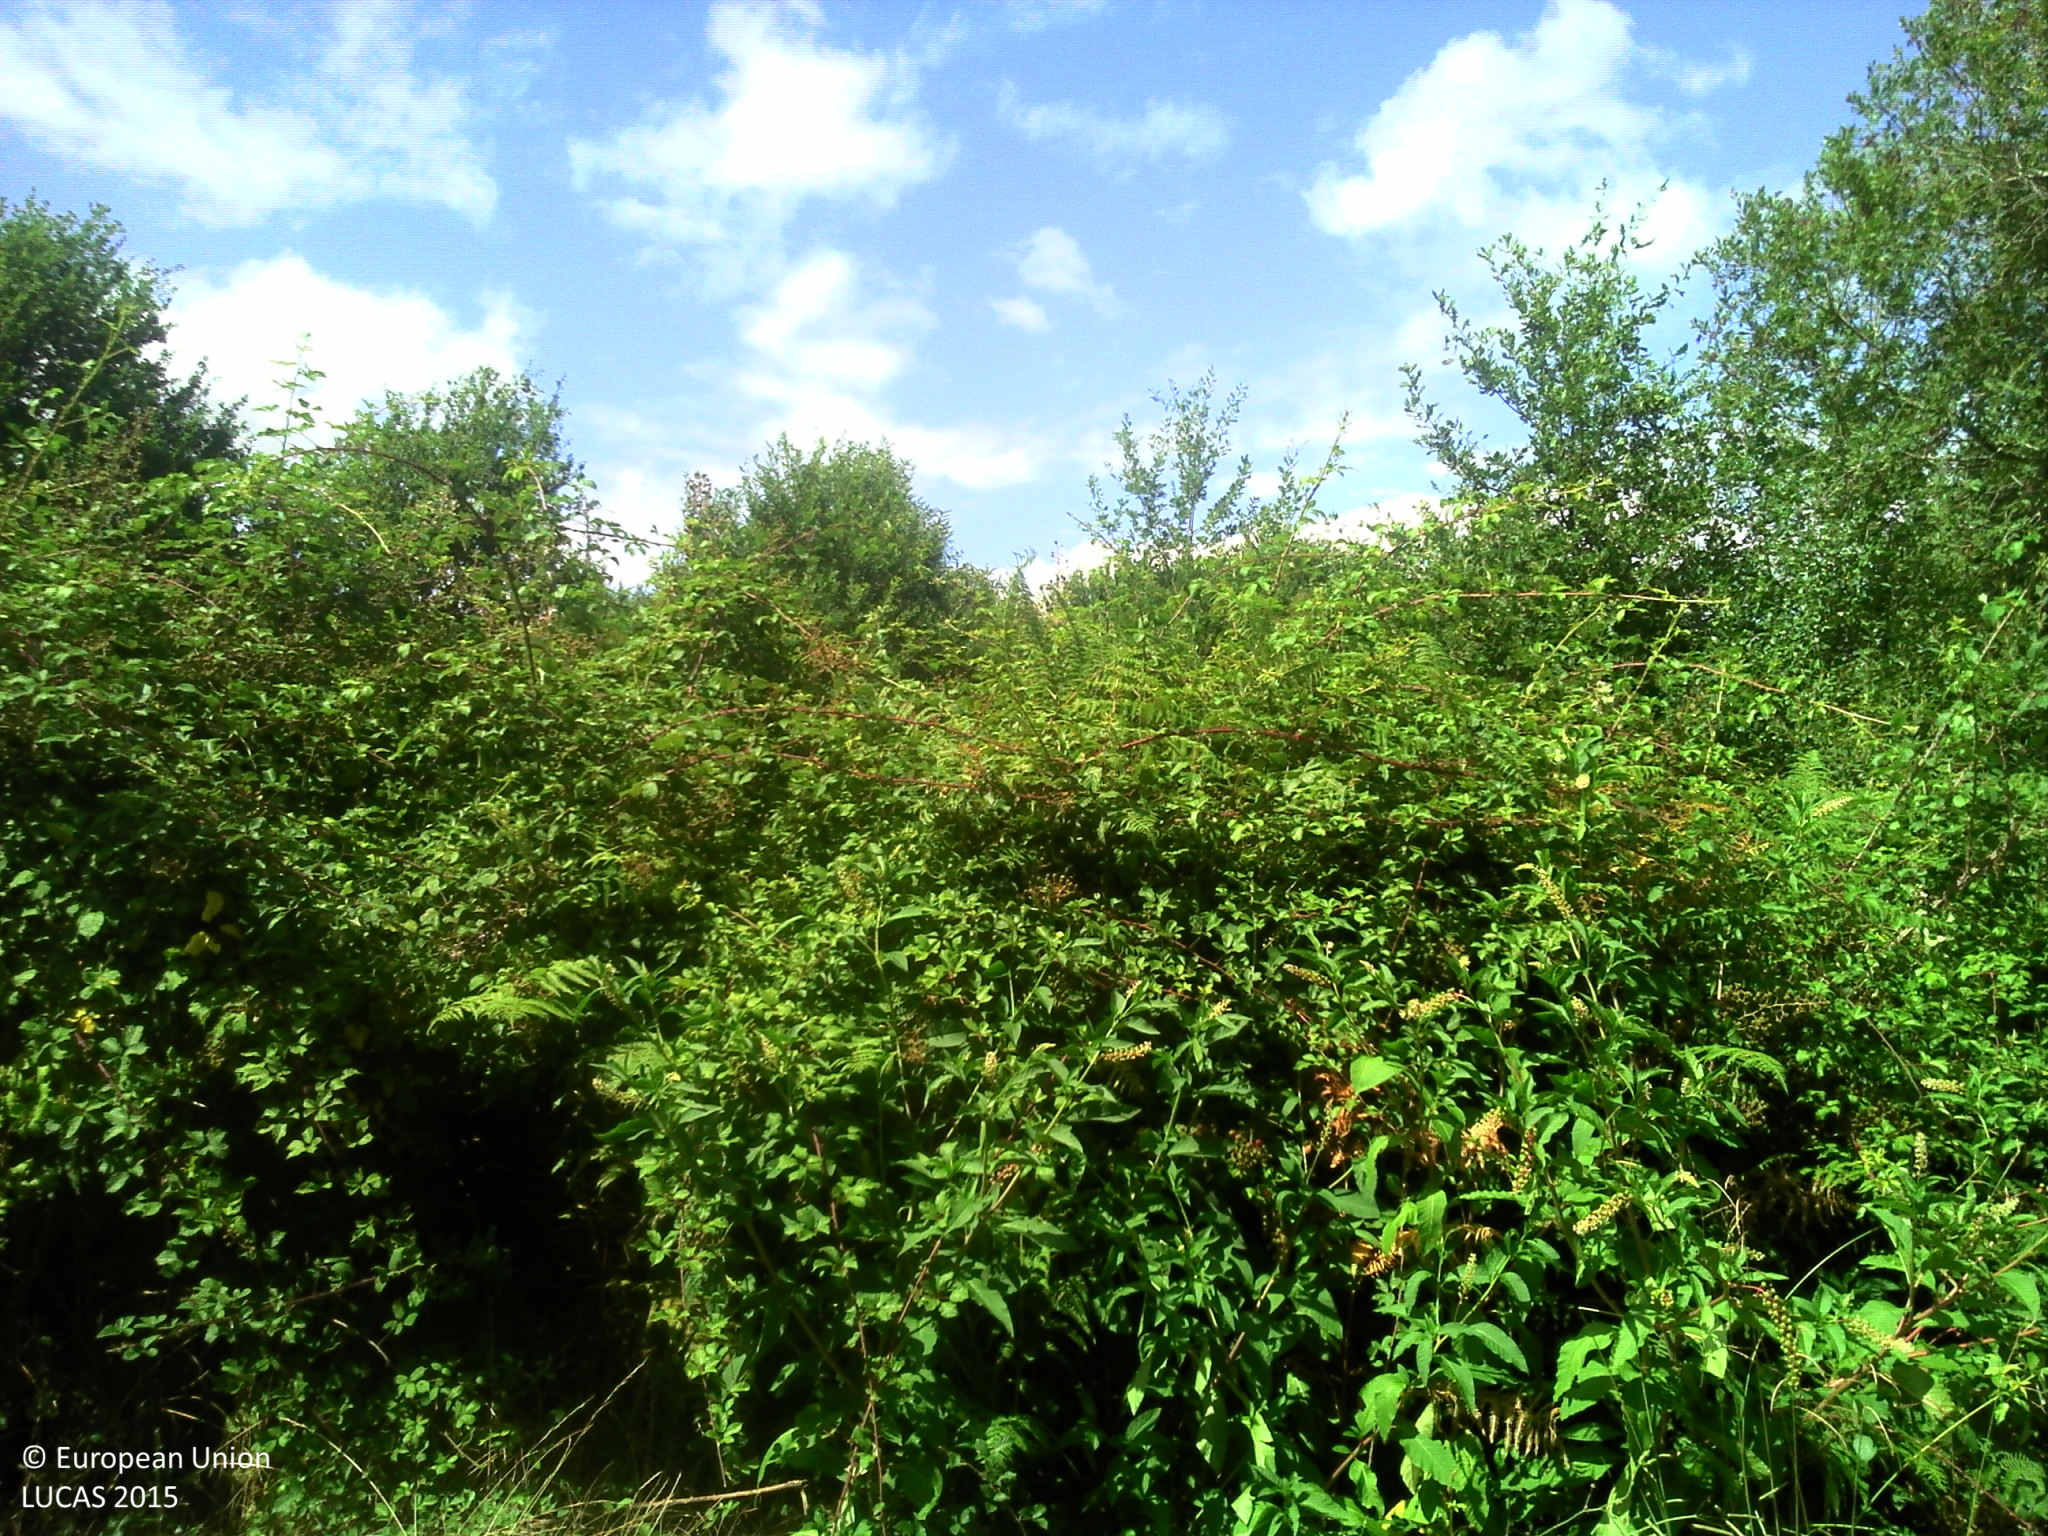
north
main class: Woodland
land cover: Broadleaved woodland
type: thermophilous deciduous forest
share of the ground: > 75 %
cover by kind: broadleaved forest trees 85 %, herbaceous plants 10 %, coniferous forest trees 5 %
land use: Forestry
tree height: > 5 m
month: July
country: FR
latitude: 43.9801
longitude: -0.8492
